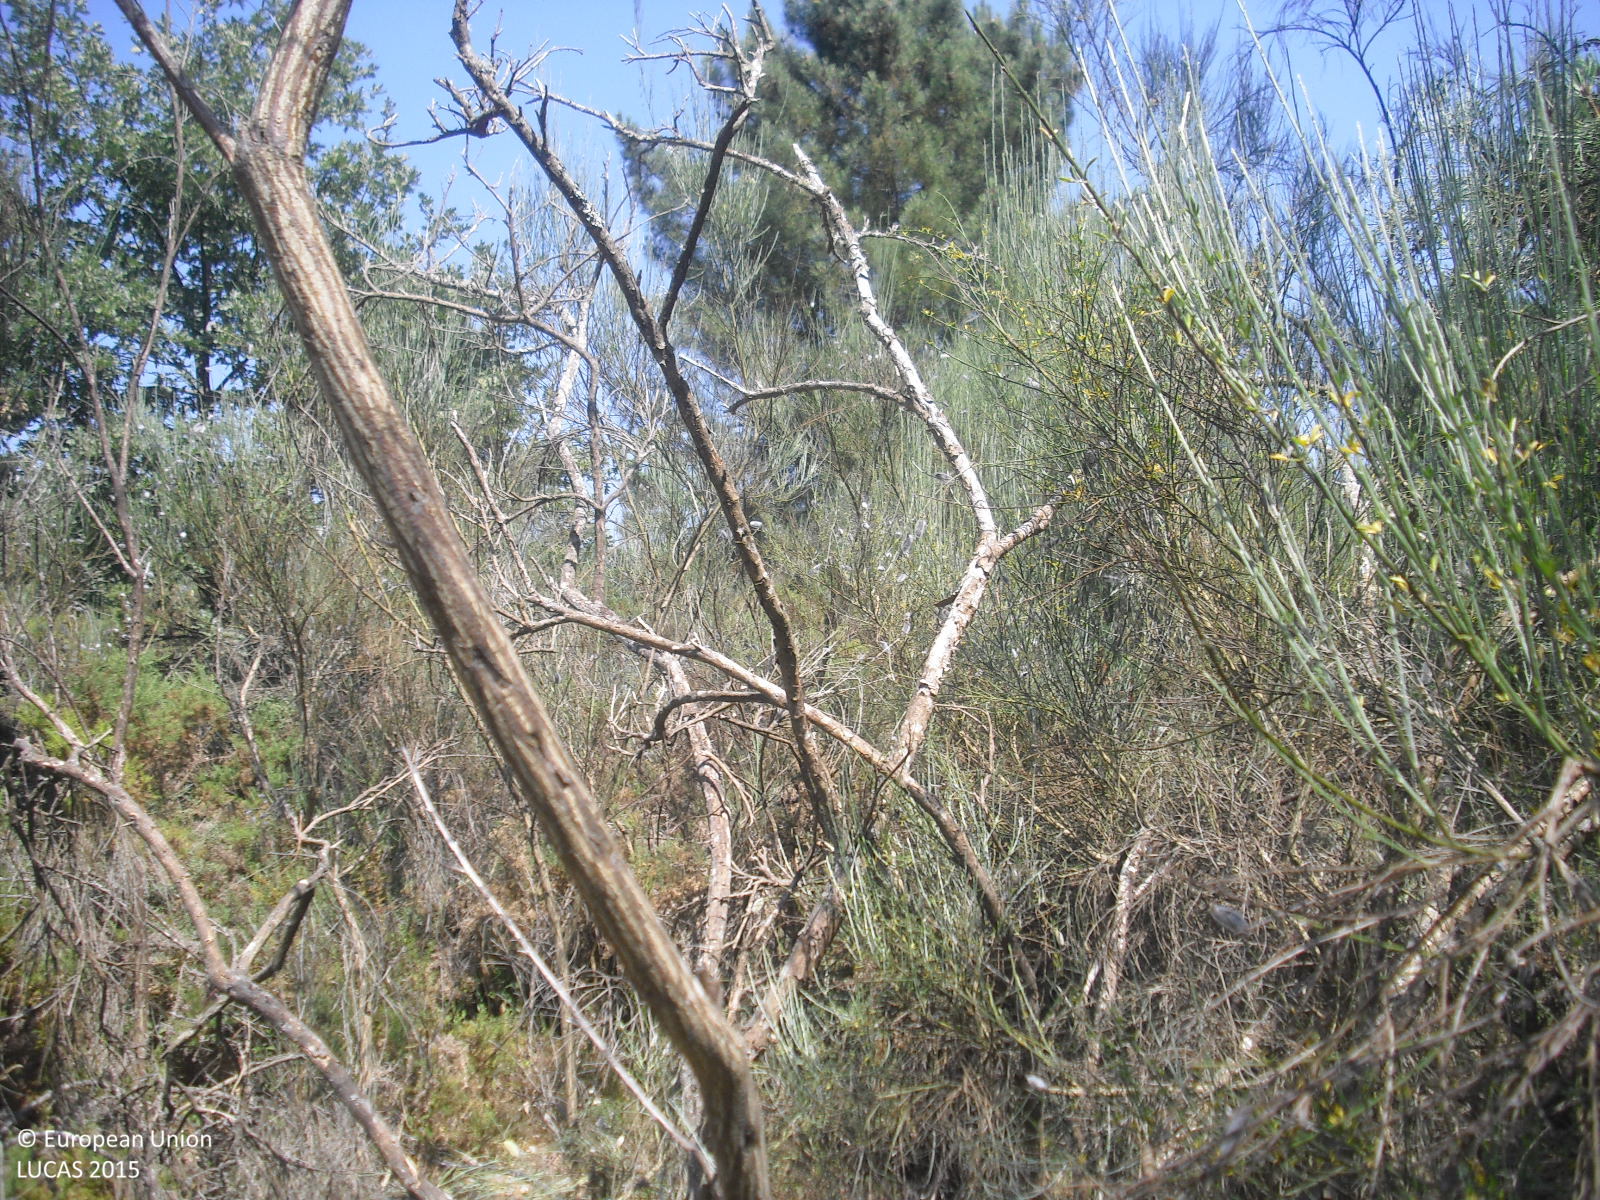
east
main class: Woodland
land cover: Pine dominated mixed woodland
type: hemiboreal forest and nemoral coniferous forest and mixed broadleaved-coniferous forest
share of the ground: 25 - 50 %
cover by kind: shrubs 55 %, coniferous forest trees 30 %, broadleaved forest trees 15 %
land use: Forestry
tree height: > 5 m
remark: Clear cut
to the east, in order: Pine dominated mixed woodland; Shrubland with sparse tree cover; Tracks; Dry stone walls; Pine dominated mixed woodland; Dry stone walls; Shruby margins; Tracks; Shrubland without tree cover; Pine dominated coniferous woodland; Shrubland without tree cover
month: July
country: ES
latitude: 42.4279
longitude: -7.4853
